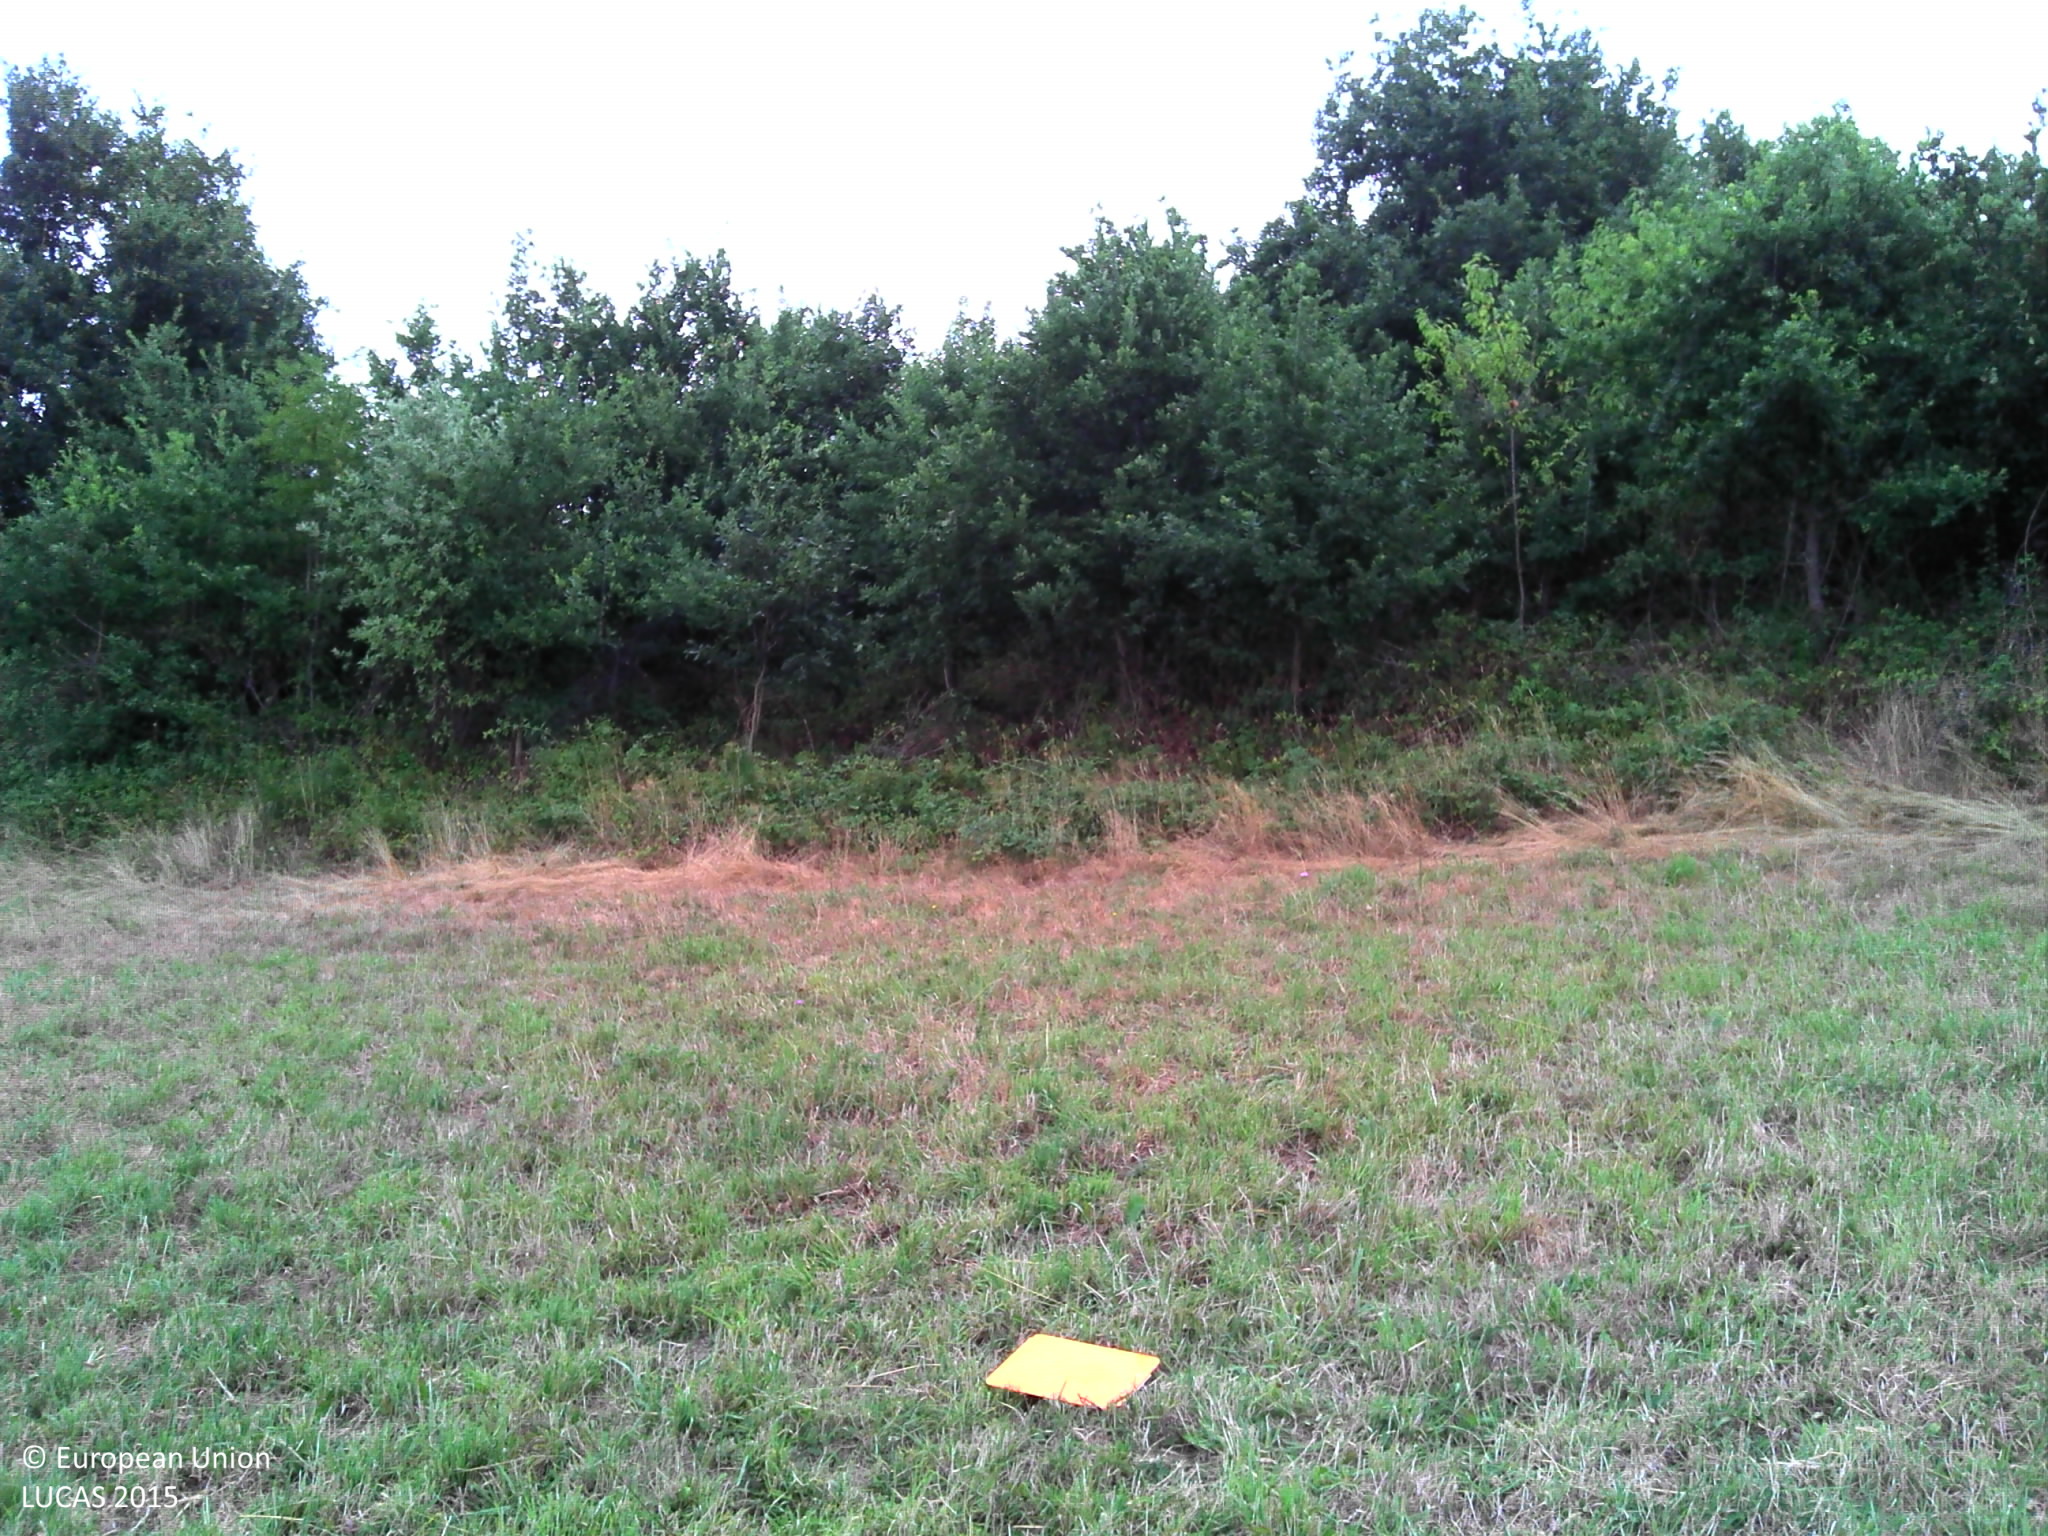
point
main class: Grassland
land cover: Grassland without tree/shrub cover
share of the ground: > 75 %
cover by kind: herbaceous plants 90 %, lichens and mosses 5 %, unconsolidated bare surface 5 %
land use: Agriculture (excluding fallow land and kitchen gardens)
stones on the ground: < 10 %
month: July
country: FR
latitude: 45.4318
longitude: 4.1364
